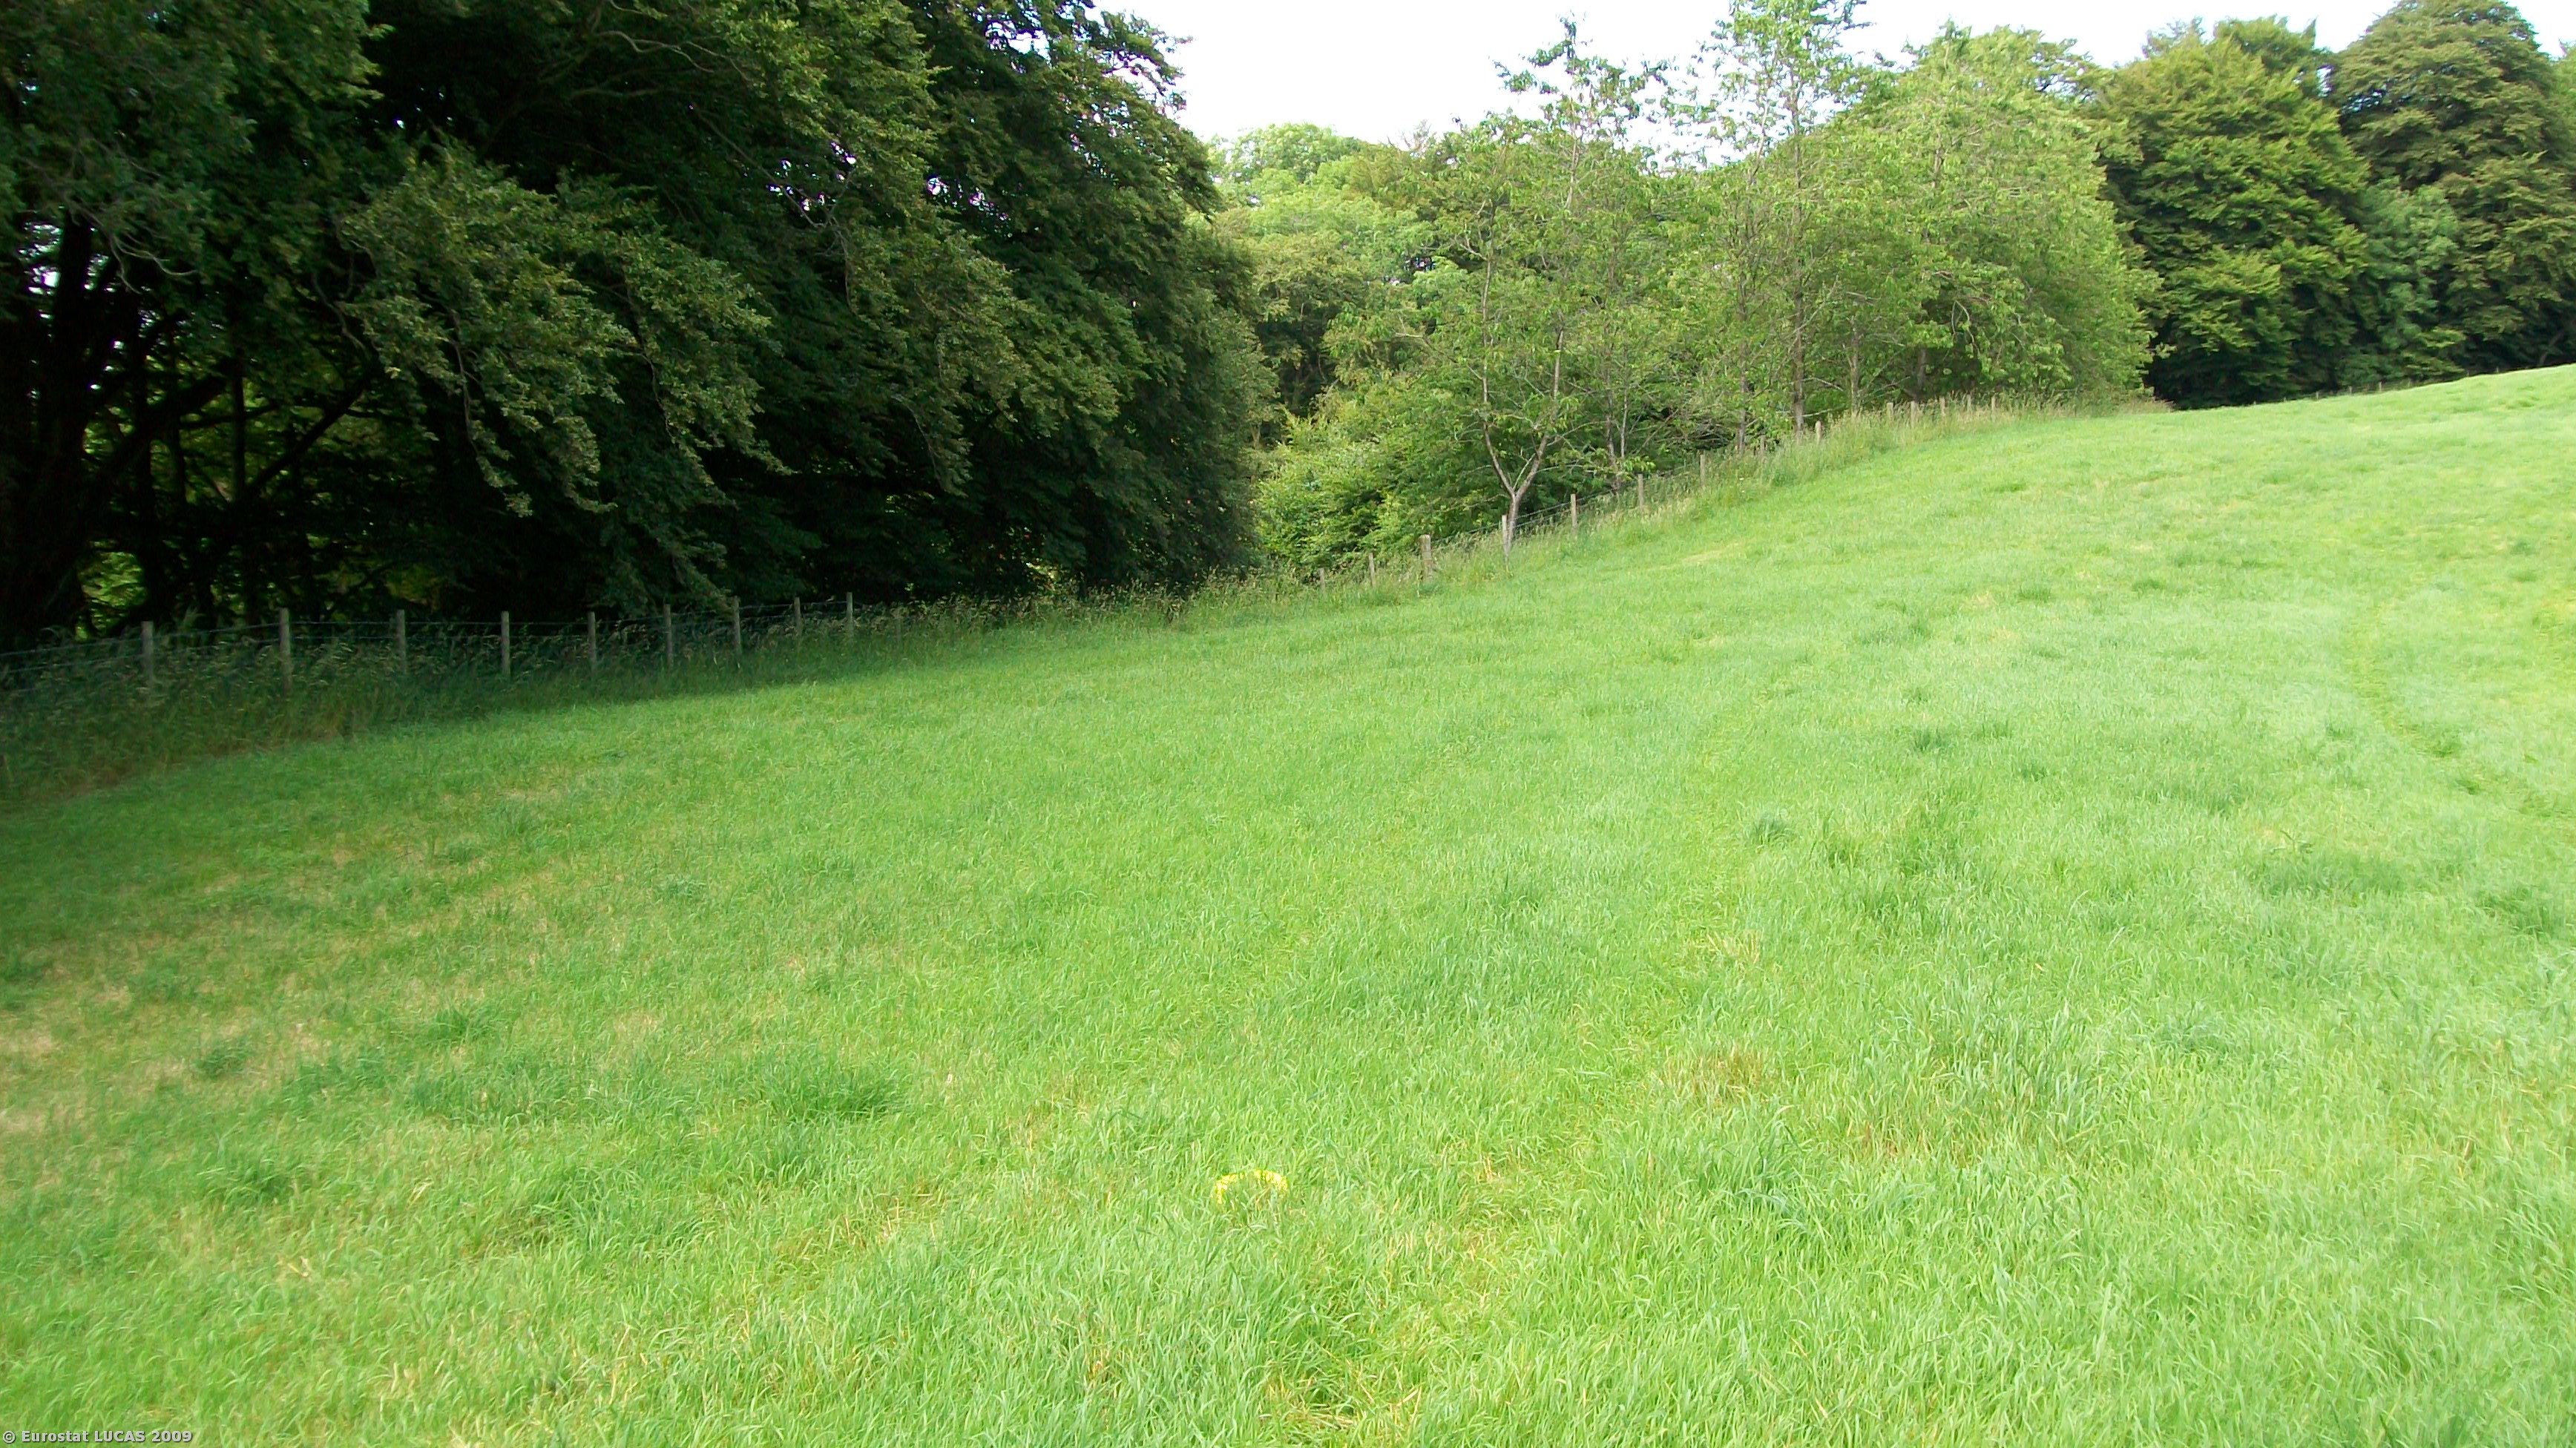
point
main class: Grassland
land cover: Grassland without tree/shrub cover
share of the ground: > 75 %
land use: Agriculture (excluding fallow land and kitchen gardens)
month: July
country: GB
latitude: 55.0030
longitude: -3.9254
